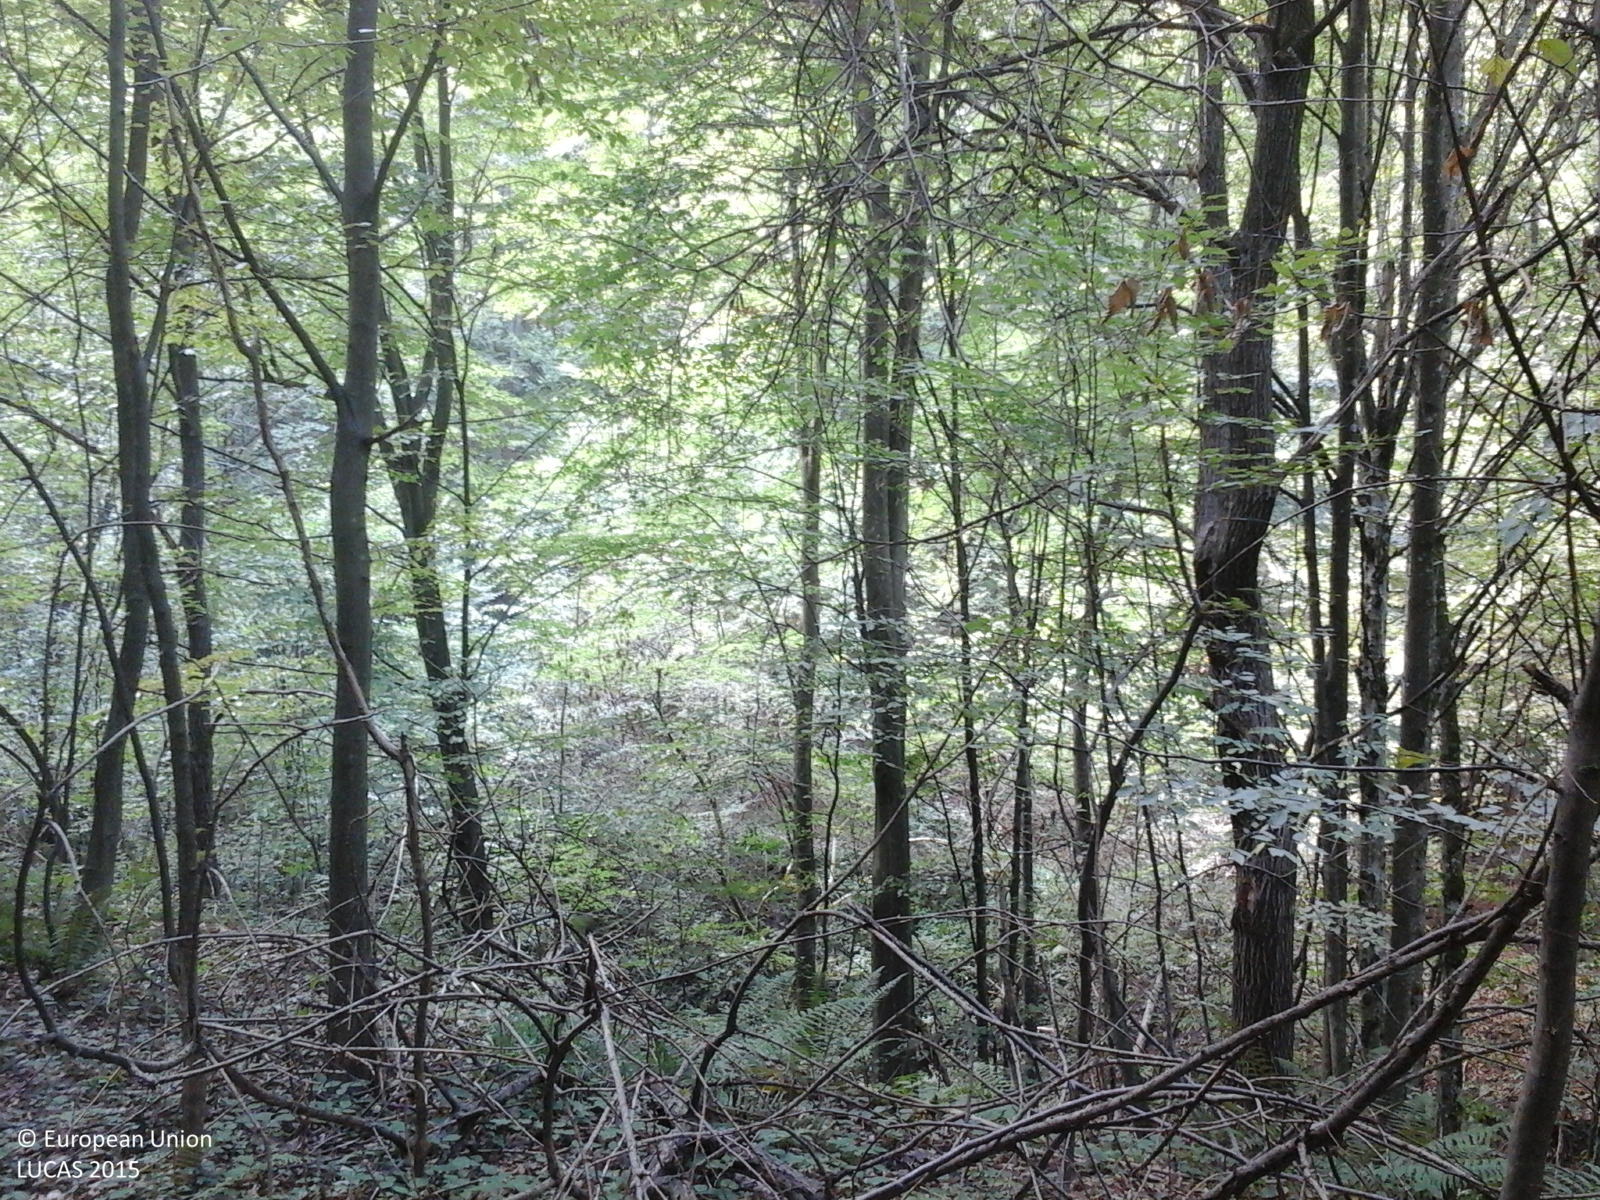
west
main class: Woodland
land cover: Broadleaved woodland
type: beech forest
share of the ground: > 75 %
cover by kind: broadleaved forest trees 100 %
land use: Forestry
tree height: > 5 m
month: September
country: RO
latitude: 45.3812
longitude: 22.0041
